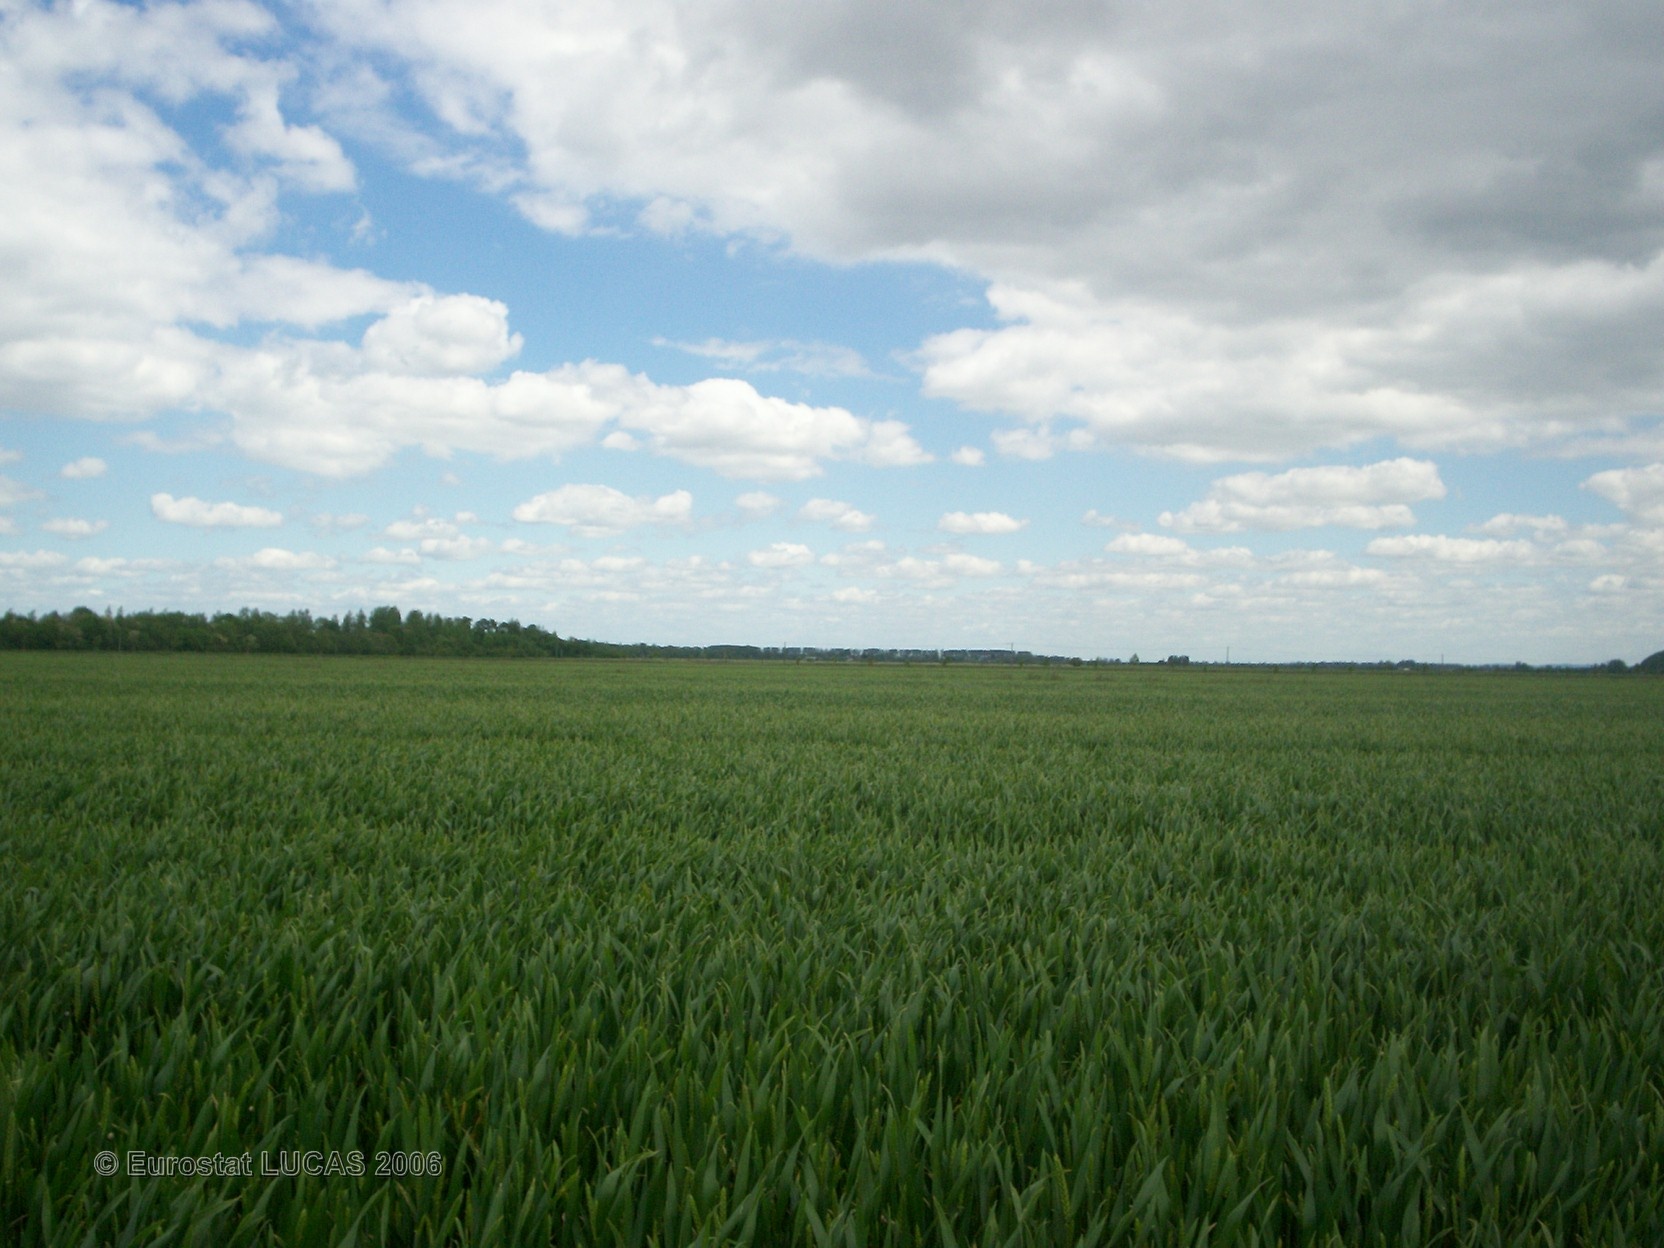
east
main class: Cropland
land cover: Barley
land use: Agriculture (excluding fallow land and kitchen gardens)
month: May
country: FR
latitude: 48.6039
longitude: -1.6444
